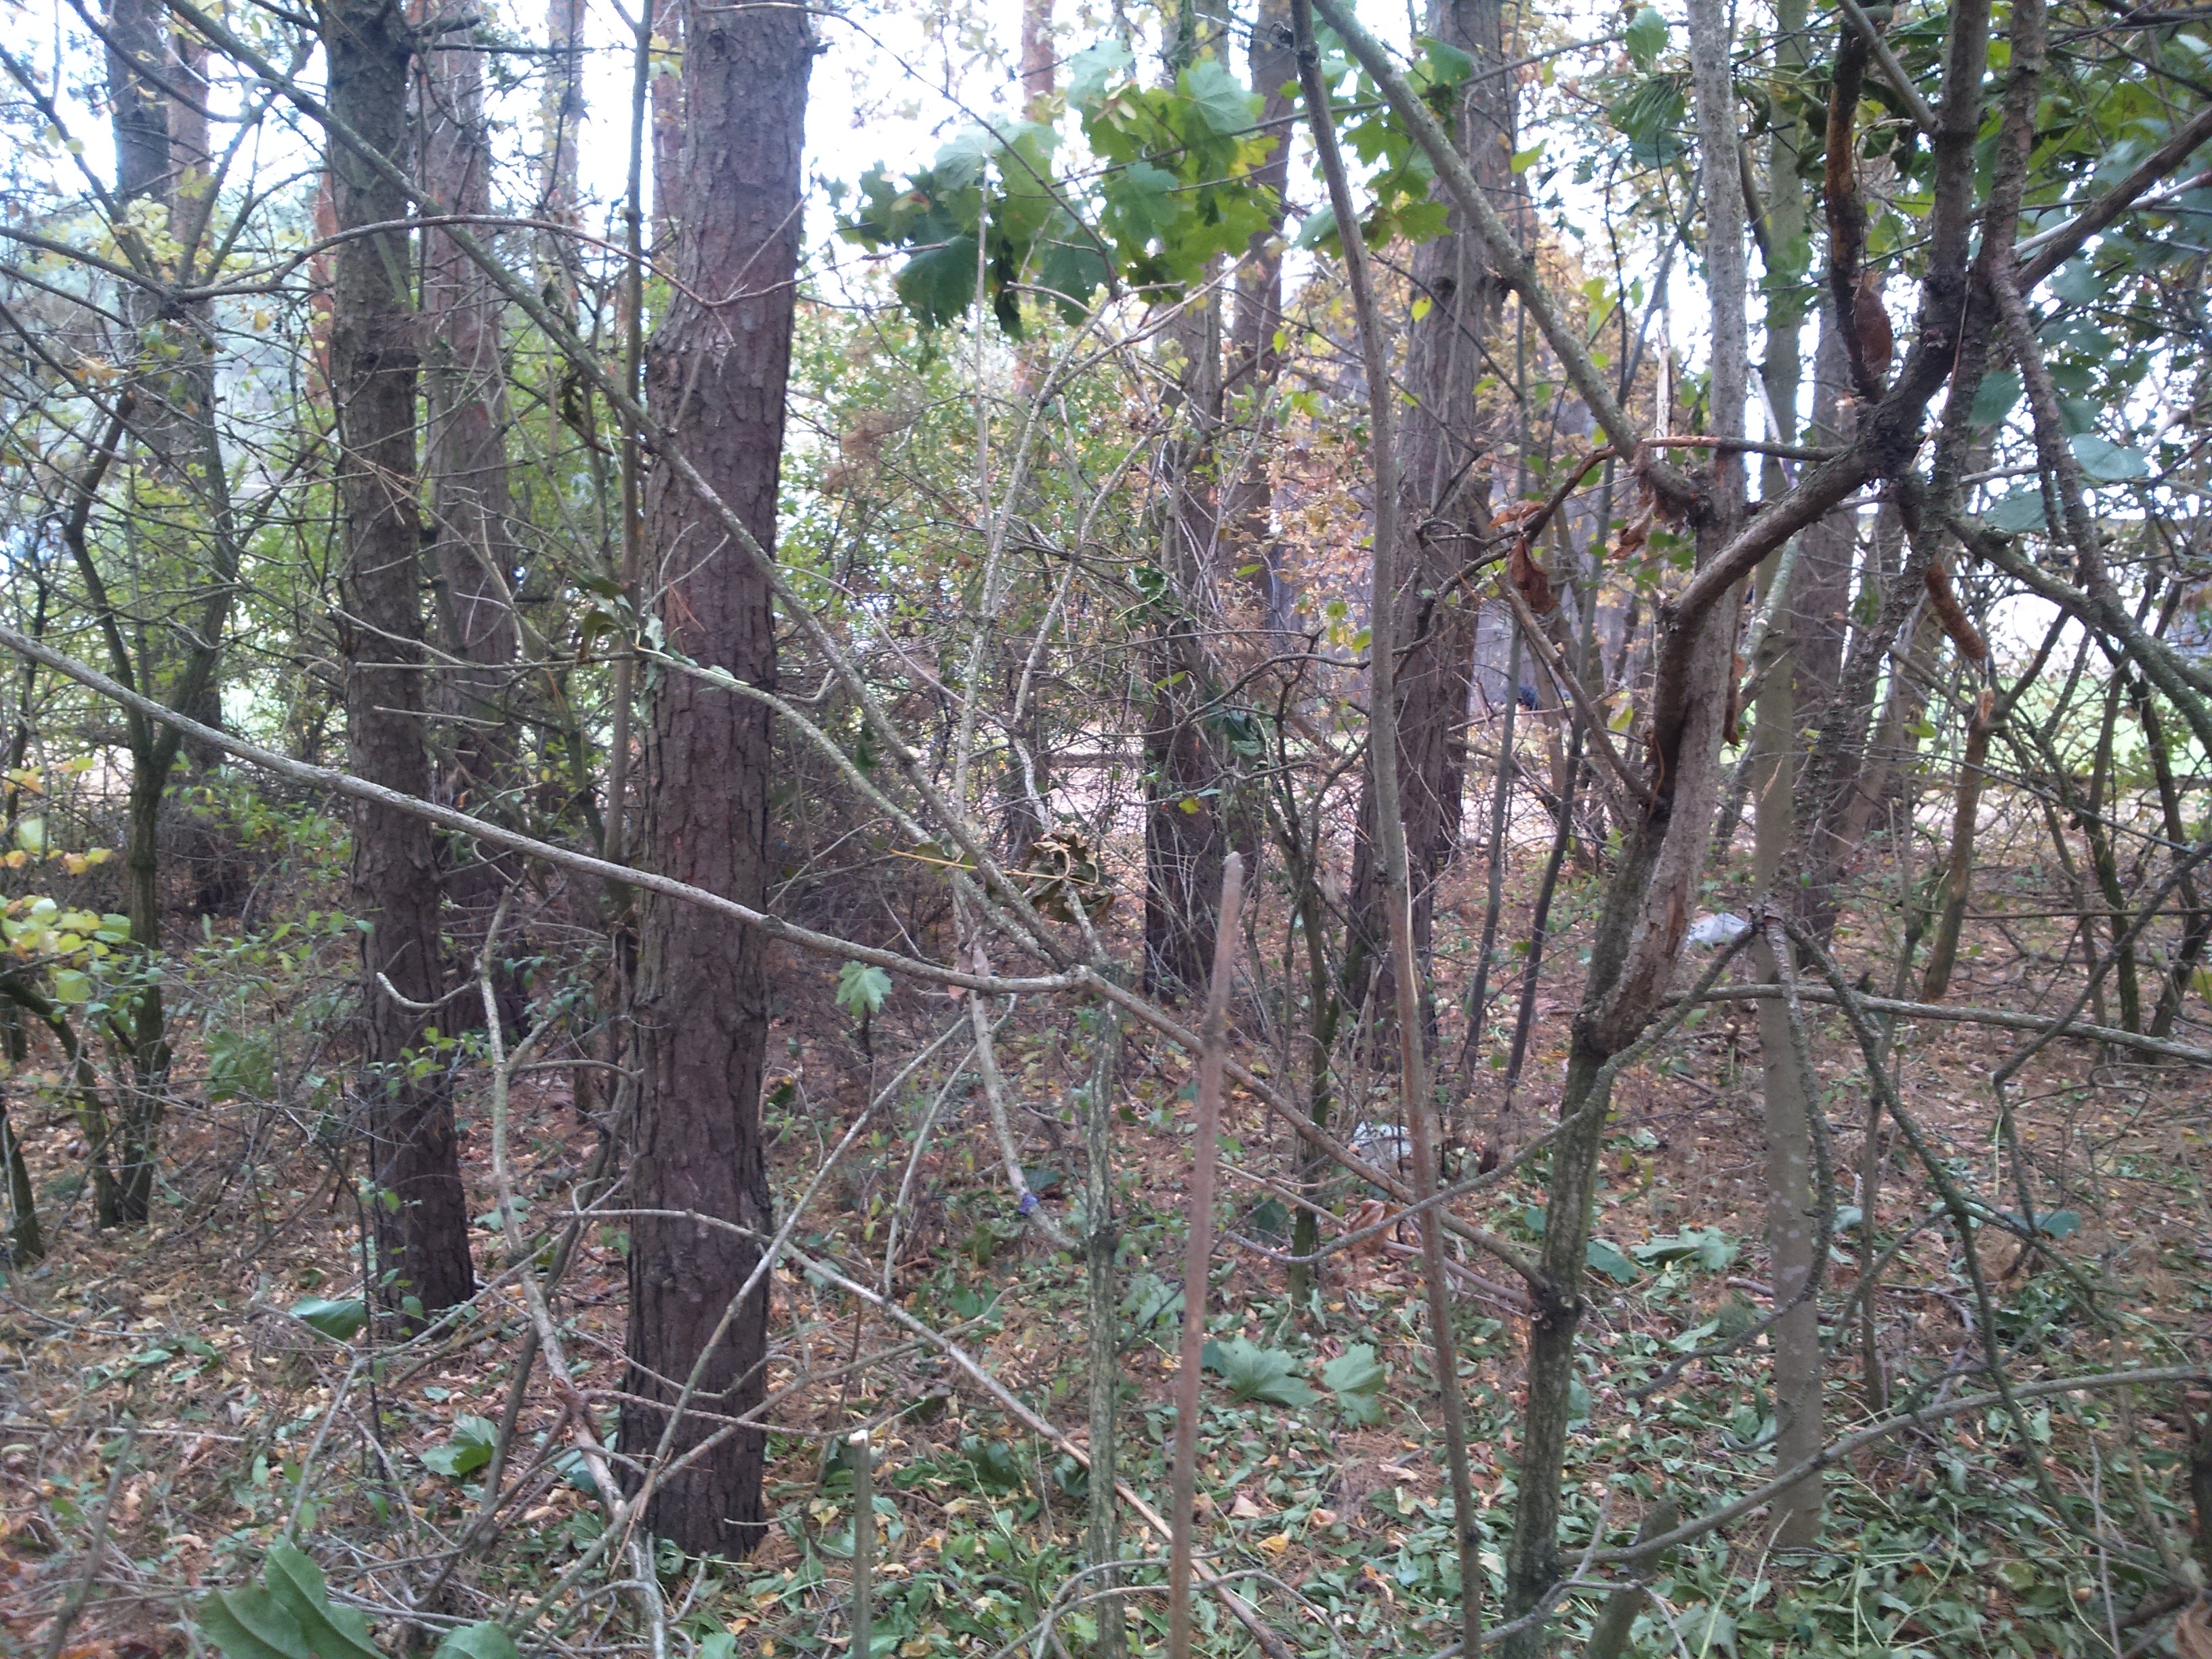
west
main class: Woodland
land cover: Pine dominated coniferous woodland
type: hemiboreal forest and nemoral coniferous forest and mixed broadleaved-coniferous forest
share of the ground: > 75 %
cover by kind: coniferous forest trees 75 %, broadleaved forest trees 15 %, shrubs 10 %
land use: Forestry
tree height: > 5 m
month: October
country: PL
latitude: 52.6991
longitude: 22.3007
